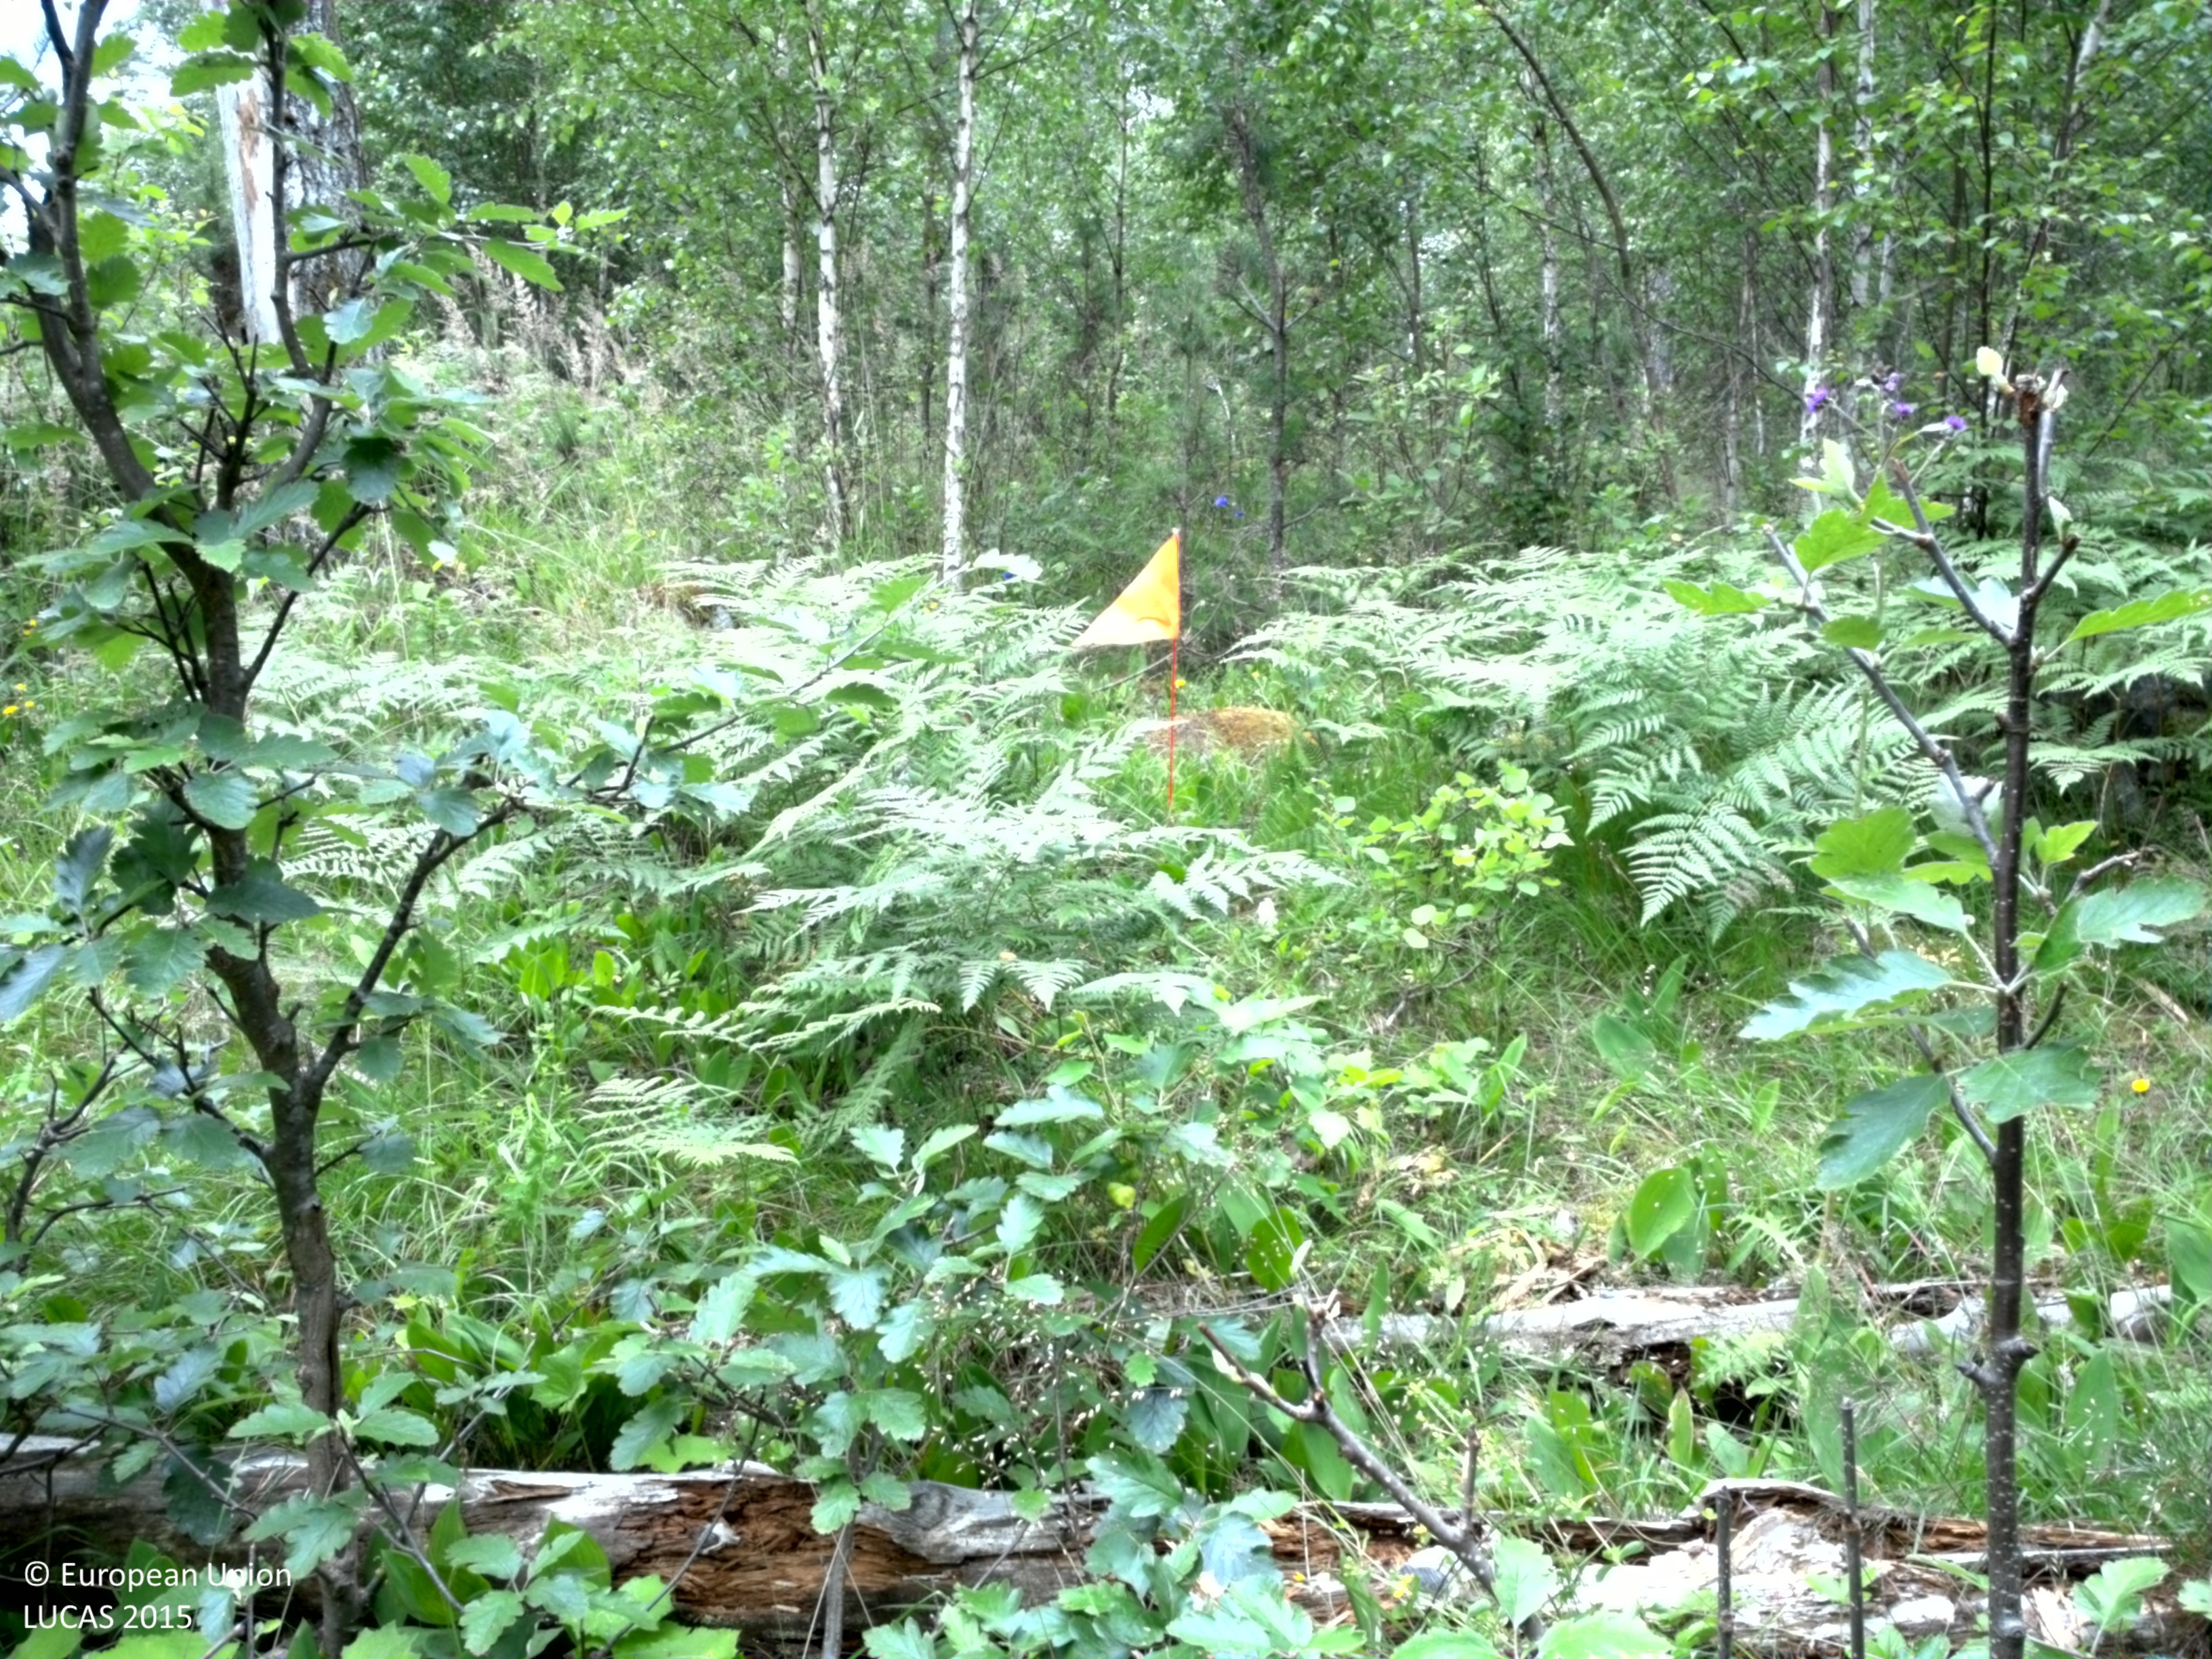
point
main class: Woodland
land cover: Broadleaved woodland
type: hemiboreal forest and nemoral coniferous forest and mixed broadleaved-coniferous forest
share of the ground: 25 - 50 %
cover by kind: herbaceous plants 50 %, broadleaved forest trees 45 %, coniferous forest trees 5 %
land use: Forestry
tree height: > 5 m
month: July
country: SE
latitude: 59.7728
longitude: 18.6007
